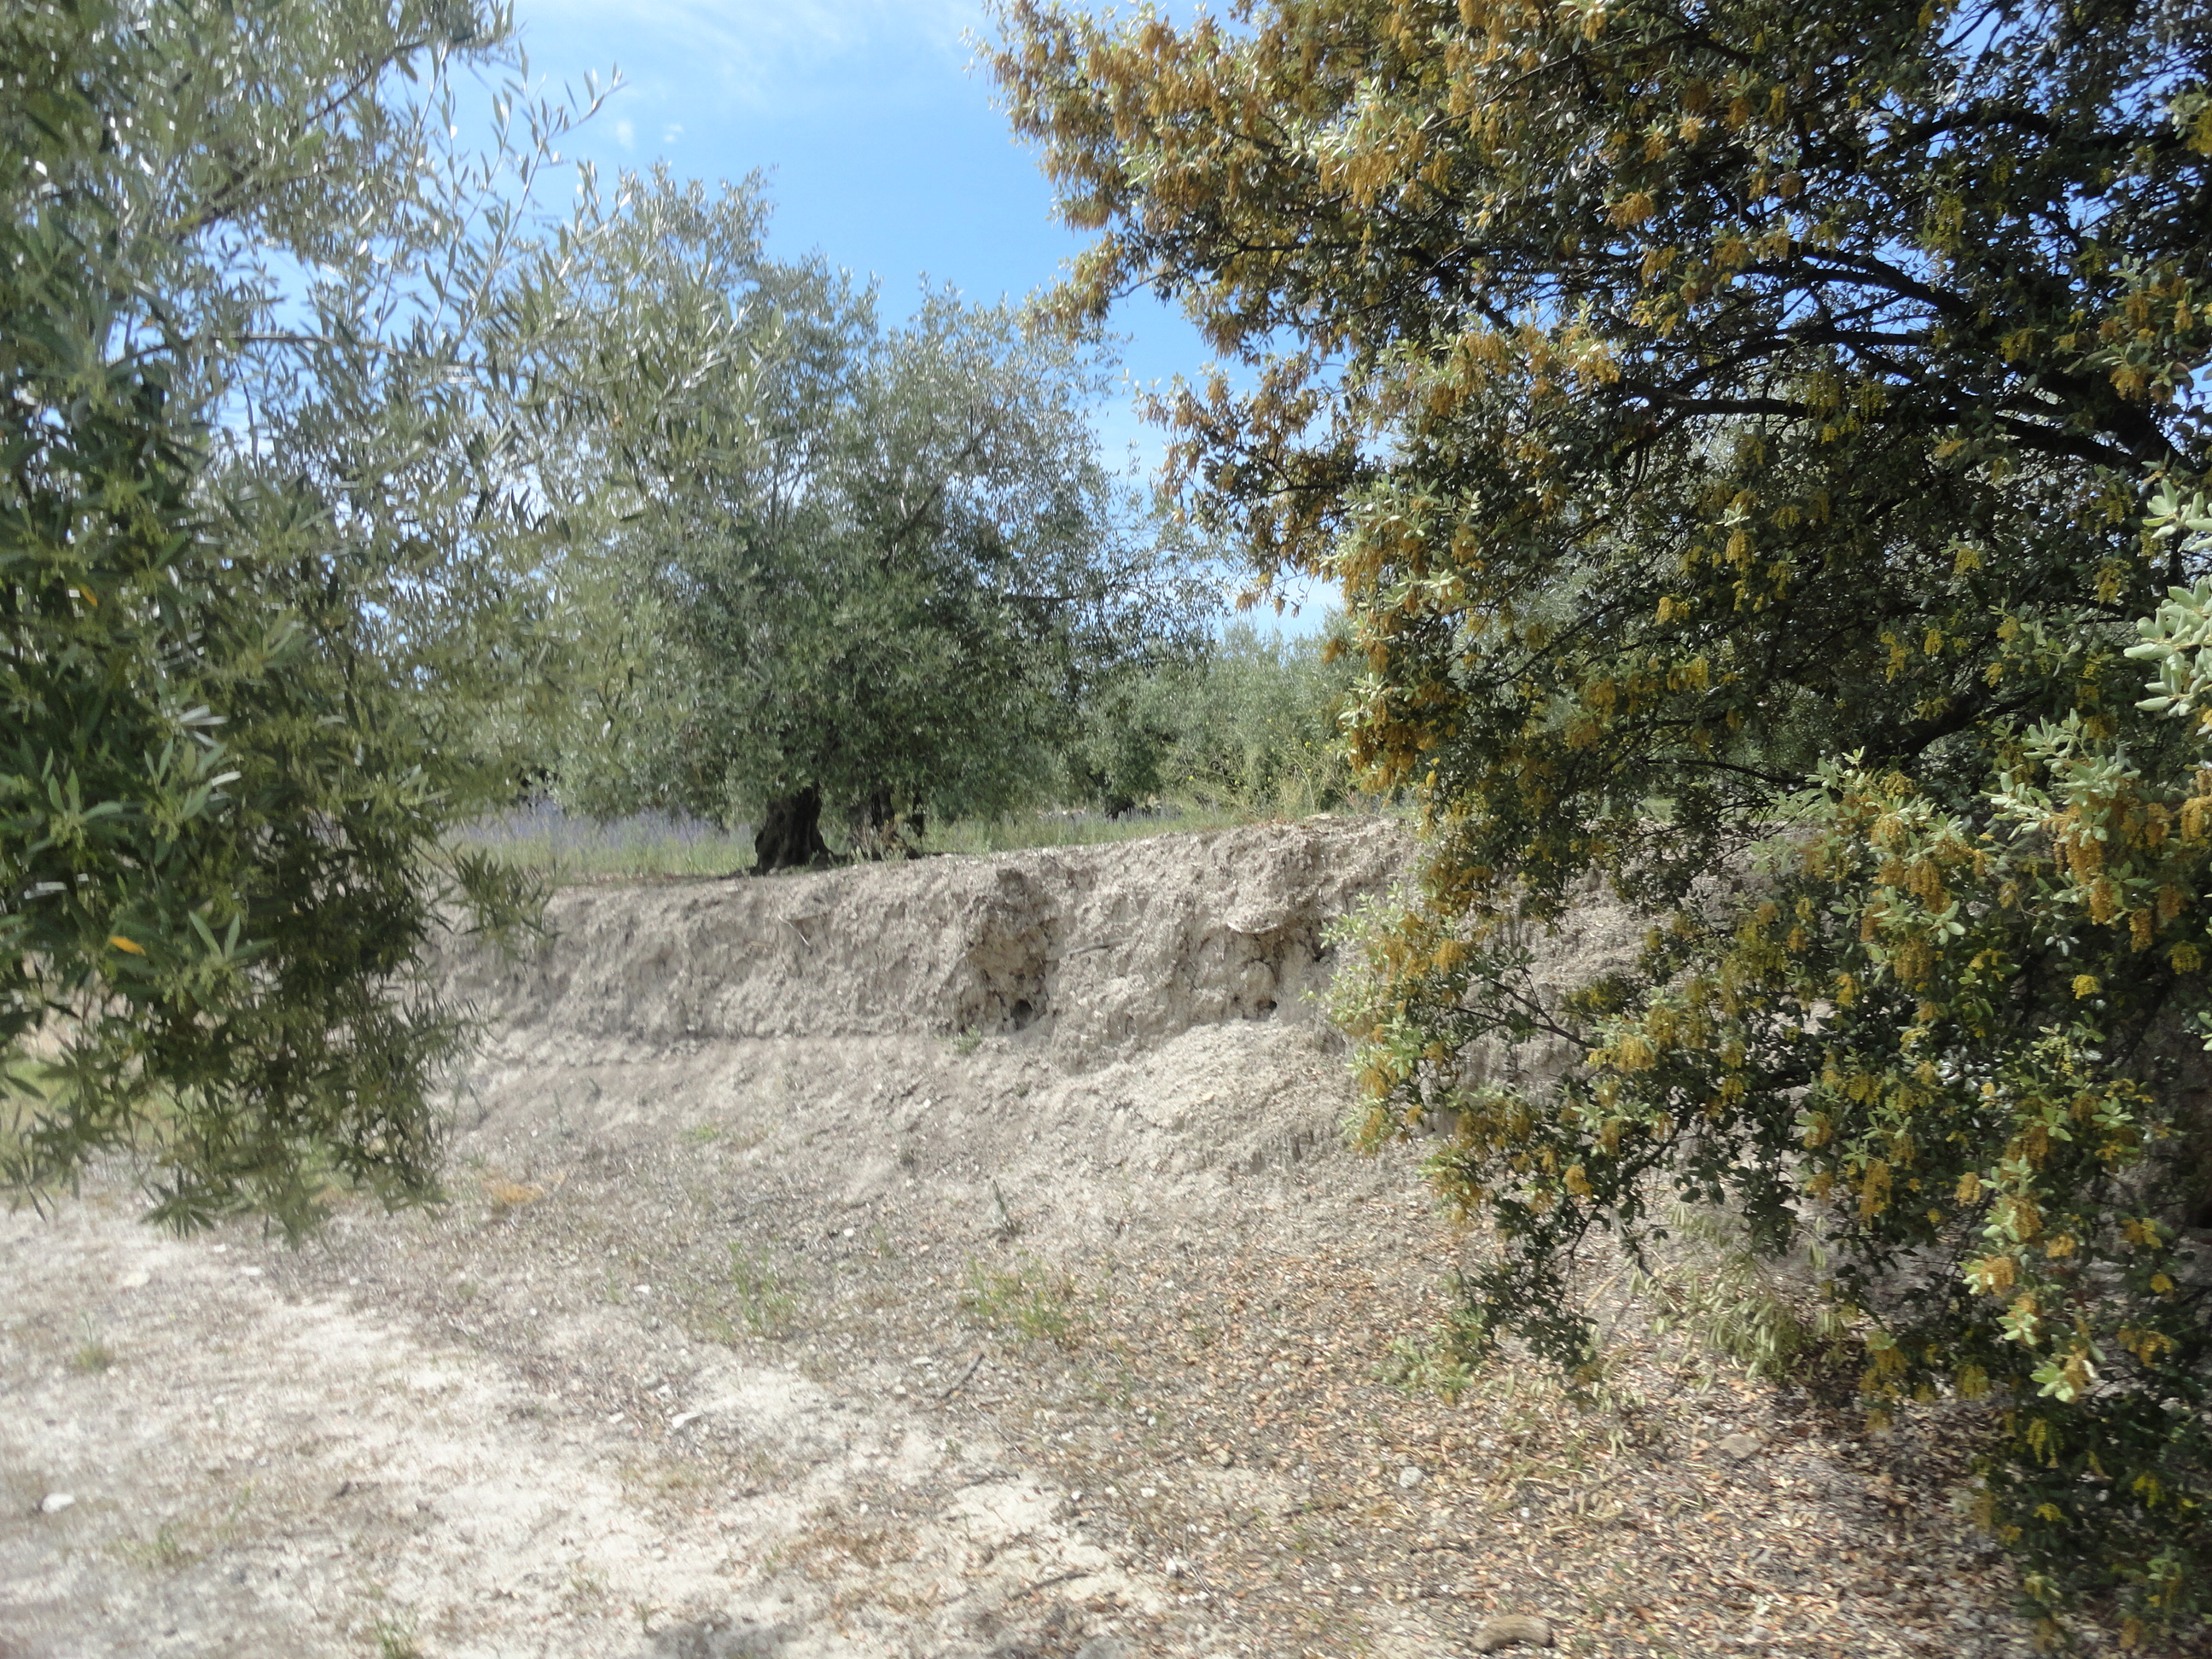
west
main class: Cropland
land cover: Olive groves
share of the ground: 50 - 75 %
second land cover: Spontaneously vegetated surfaces
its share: 10 - 25 %
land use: Agriculture (excluding fallow land and kitchen gardens)
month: April
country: ES
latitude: 37.6121
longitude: -4.4494
